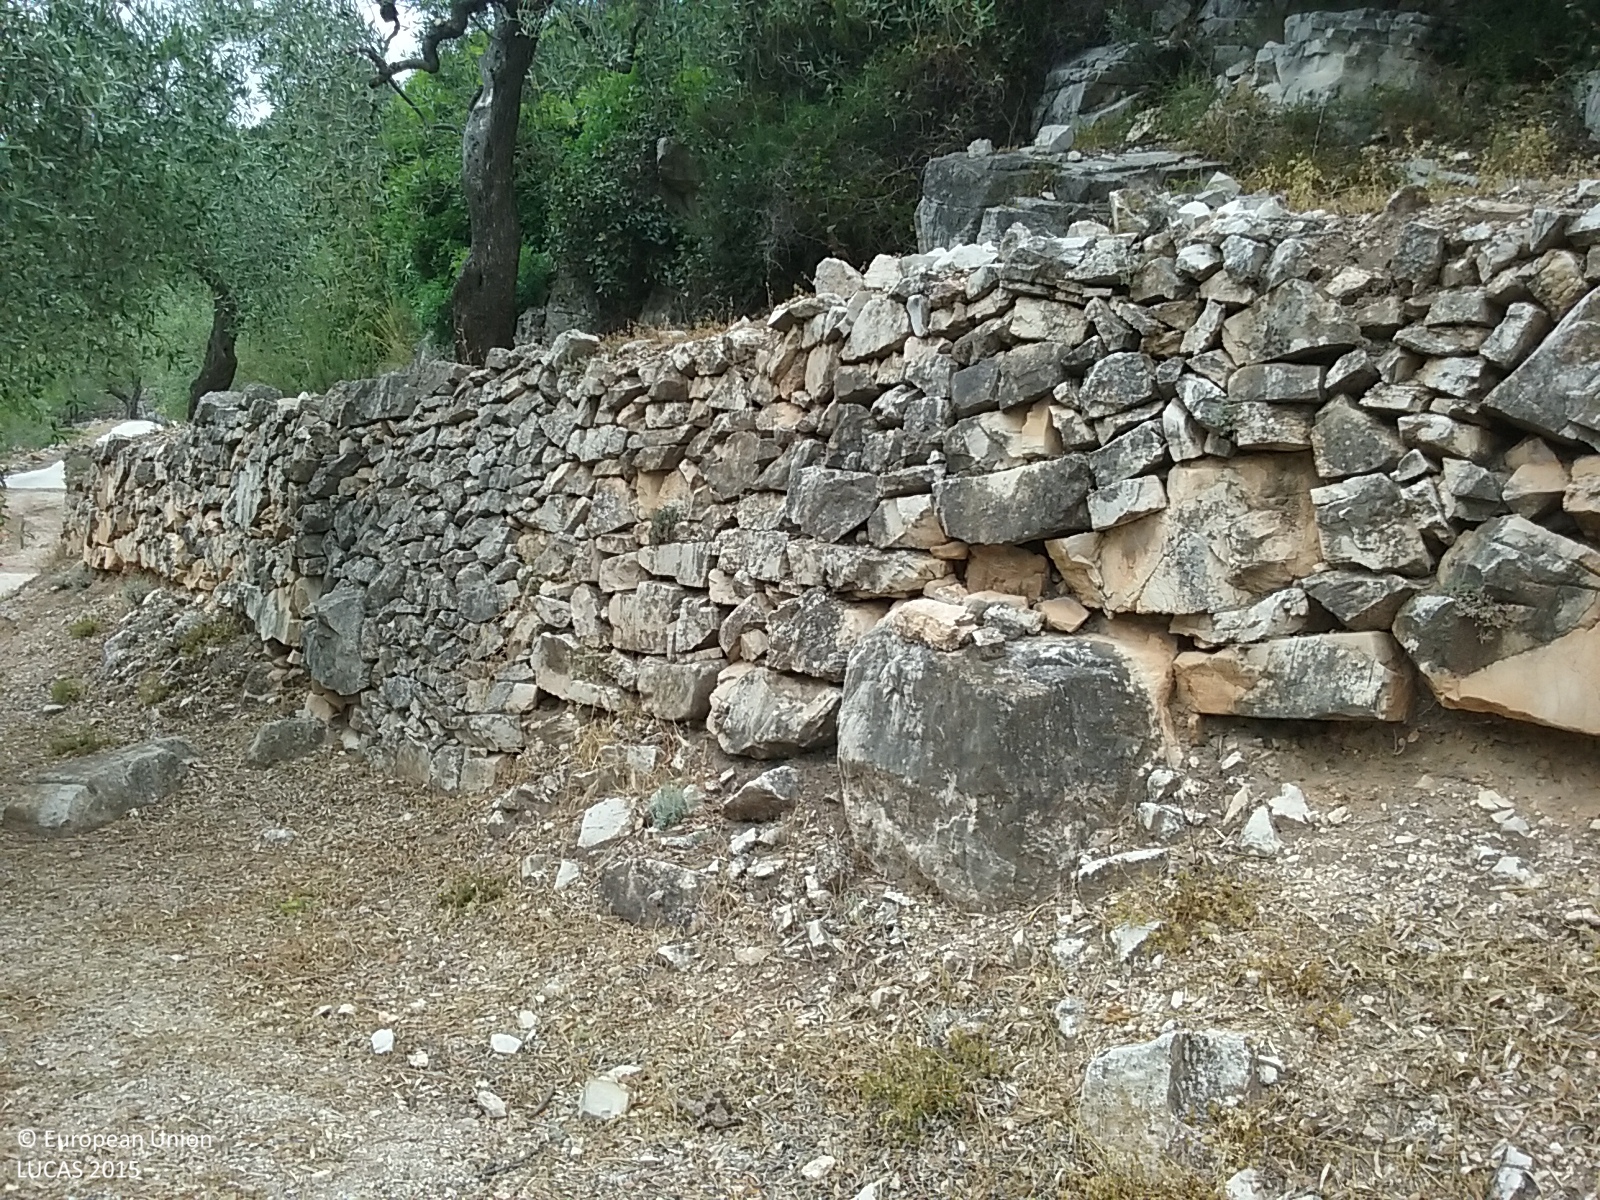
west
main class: Cropland
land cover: Olive groves
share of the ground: 25 - 50 %
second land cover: Other bare soil
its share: > 75 %
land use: Agriculture (excluding fallow land and kitchen gardens)
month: June
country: ES
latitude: 40.9429
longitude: 0.4065
